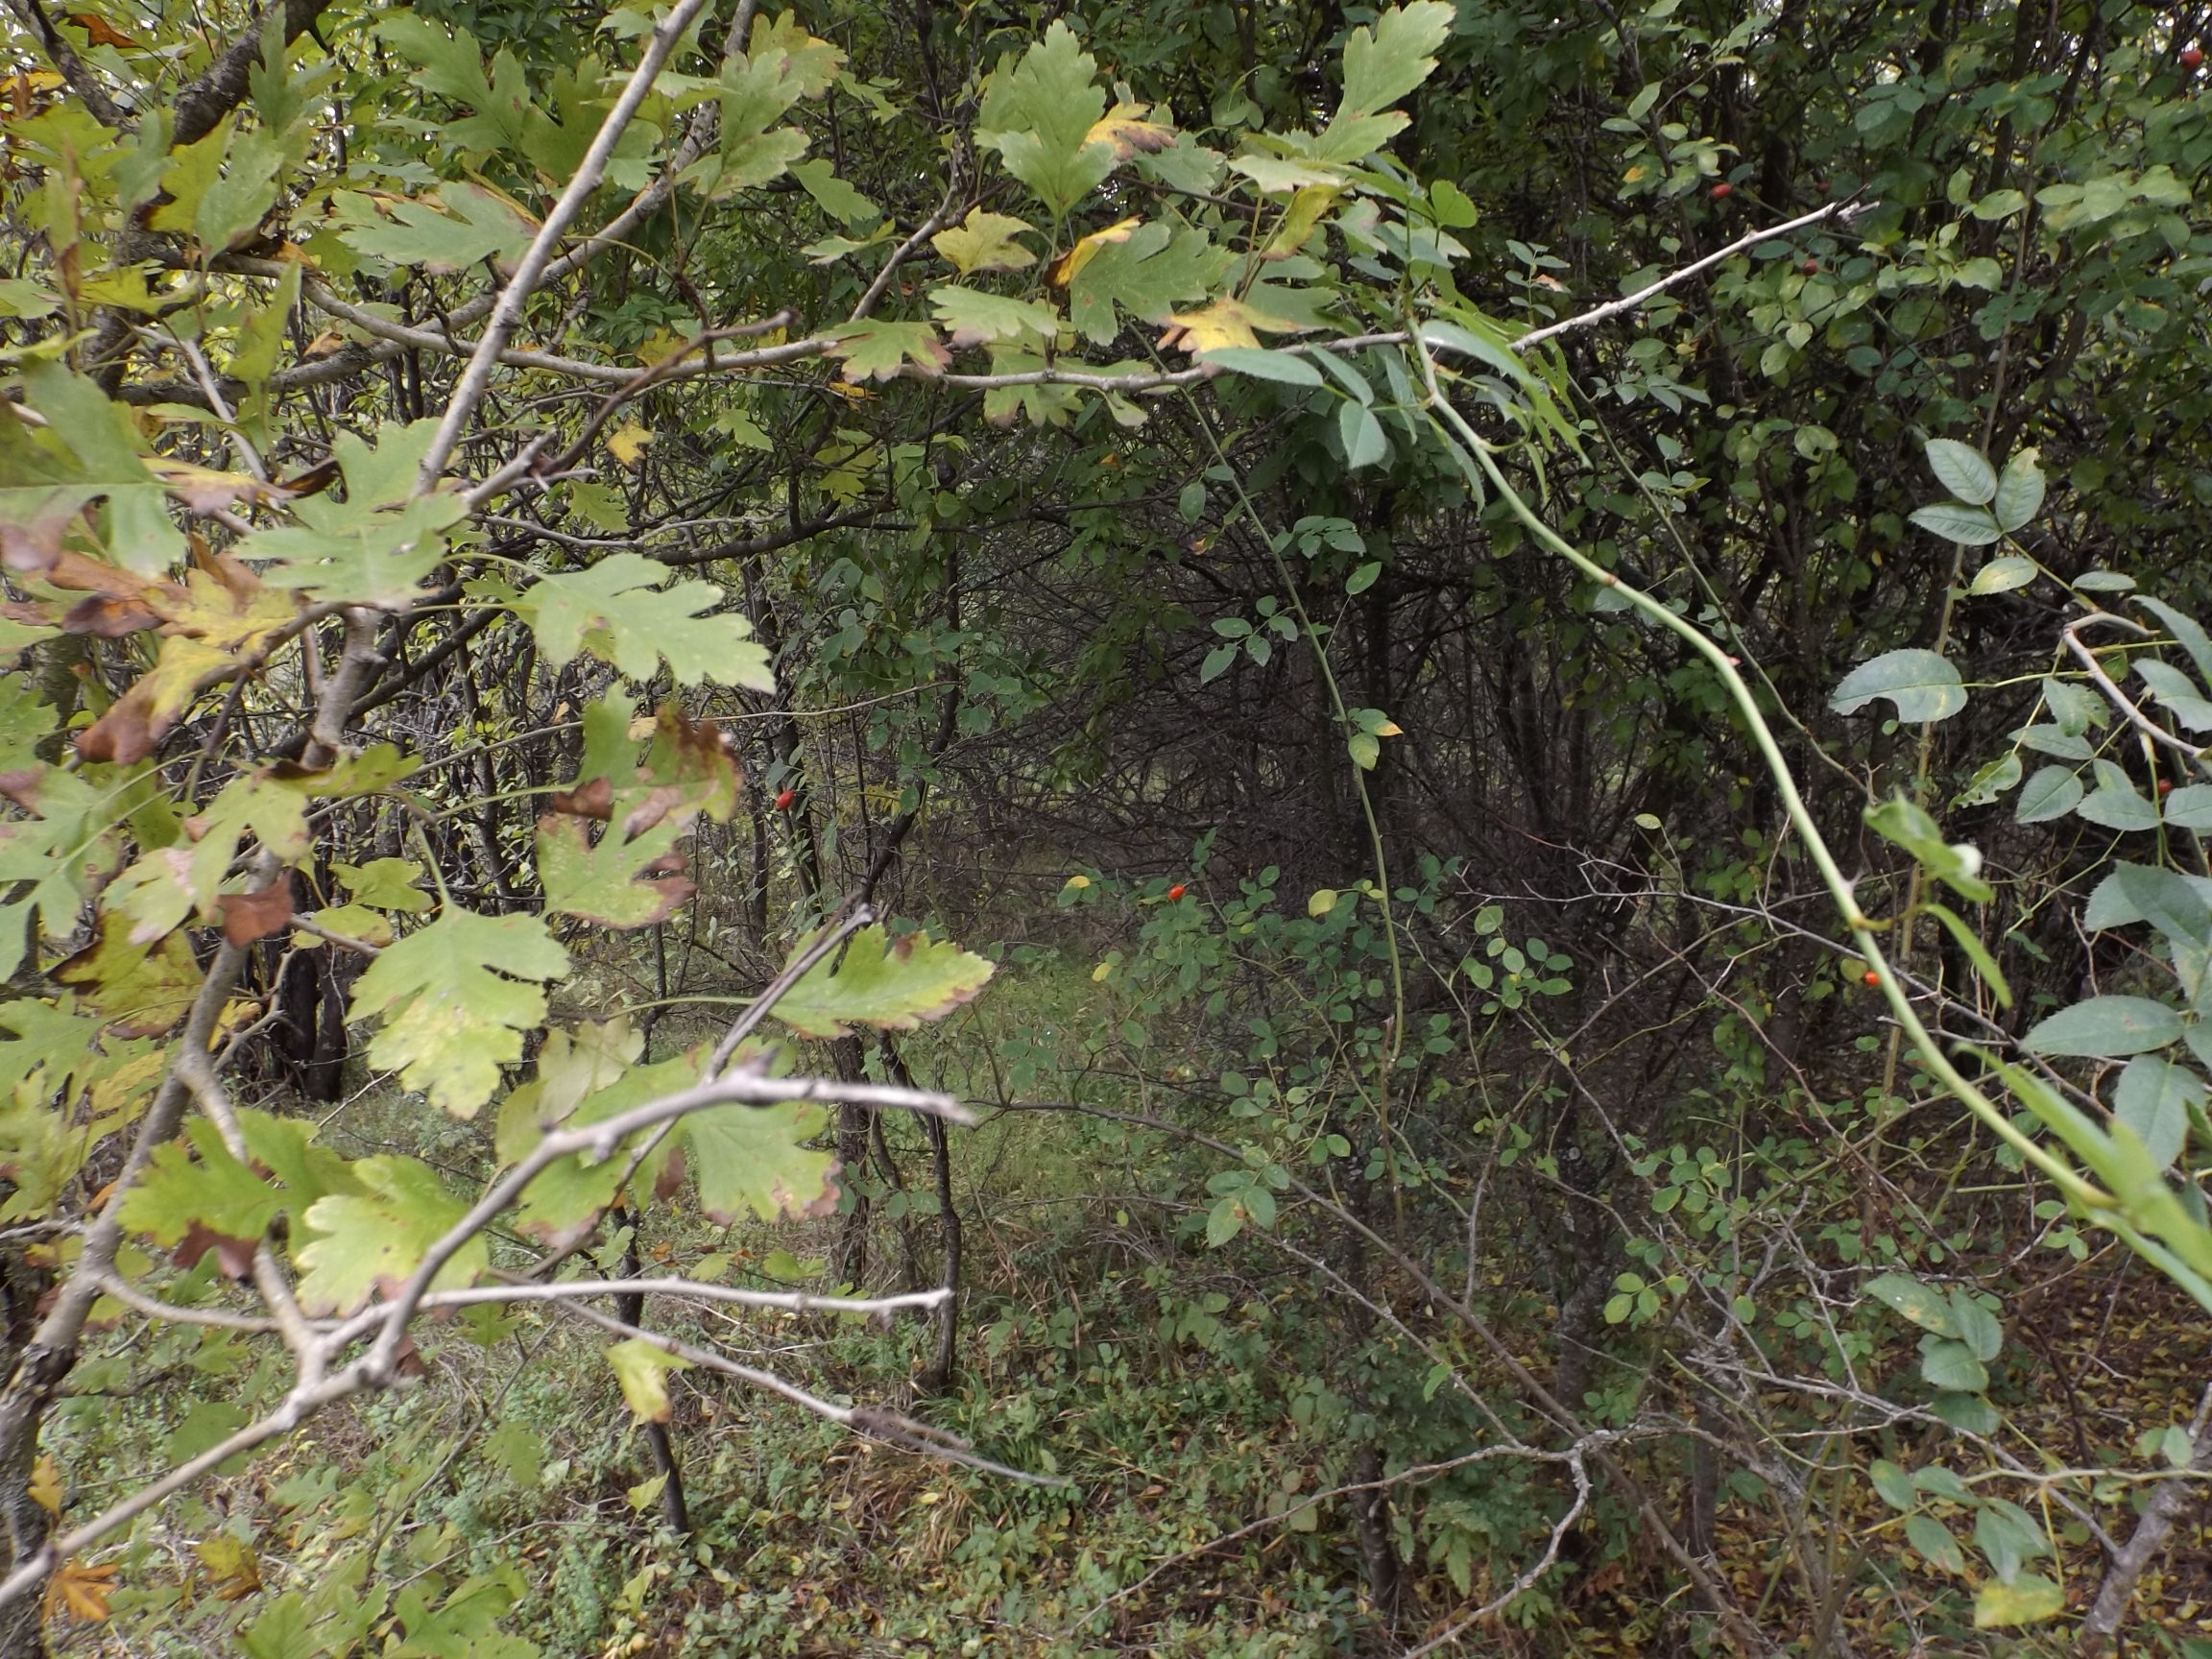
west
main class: Shrubland
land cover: Shrubland with sparse tree cover
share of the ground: > 75 %
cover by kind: shrubs 65 %, herbaceous plants 30 %, broadleaved forest trees 5 %
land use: Semi-natural and natural areas not in use
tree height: > 5 m
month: October
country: BG
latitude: 44.0313
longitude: 26.8263
